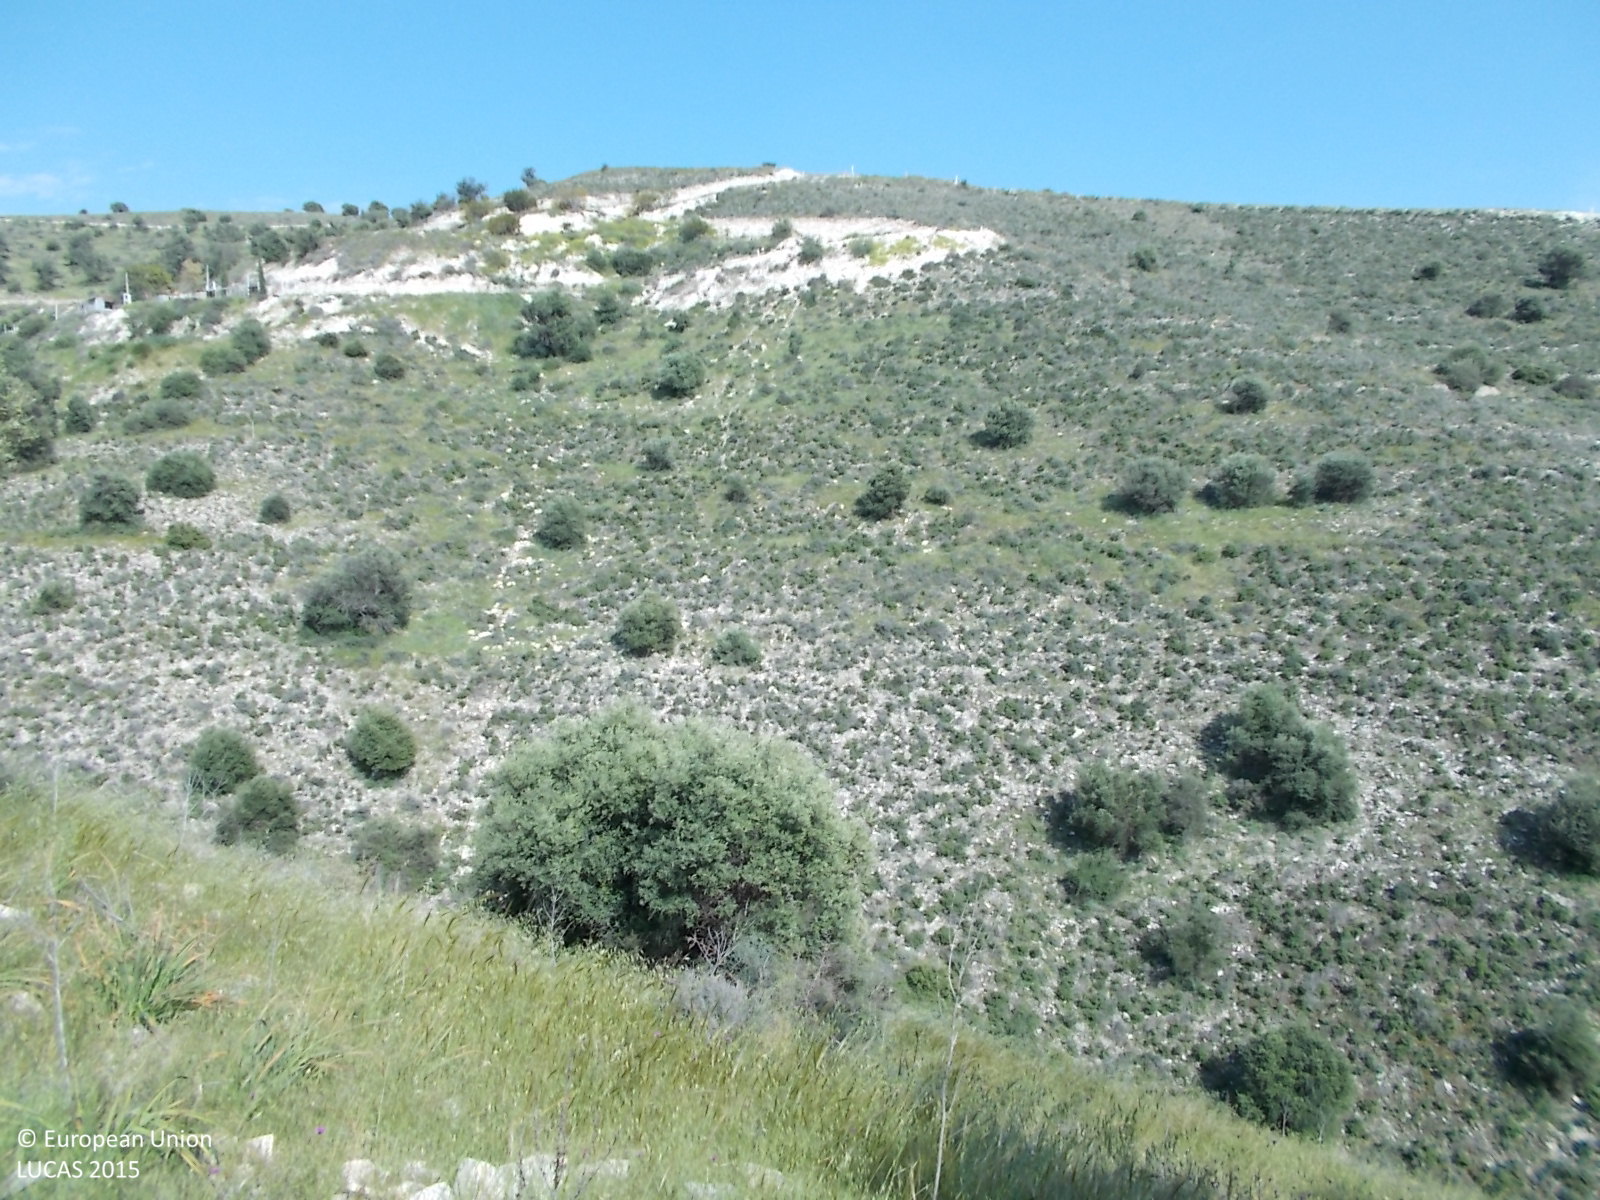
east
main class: Cropland
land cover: Olive groves
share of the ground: 25 - 50 %
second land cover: Grassland without tree/shrub cover
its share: > 75 %
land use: Abandoned areas
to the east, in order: Olive groves; Grassland without tree/shrub cover; Grassland with sparse tree/shrub cover; Rock outcrops; Shrubland without tree cover; Rivers and streams; Olive groves; Shrubland with sparse tree cover; Tracks; Shrubland with sparse tree cover; Tracks; Shrubland with sparse tree cover; Paved roads, cycling and walking lanes; Shrubland without tree cover
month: April
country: CY
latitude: 34.9507
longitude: 33.4826
